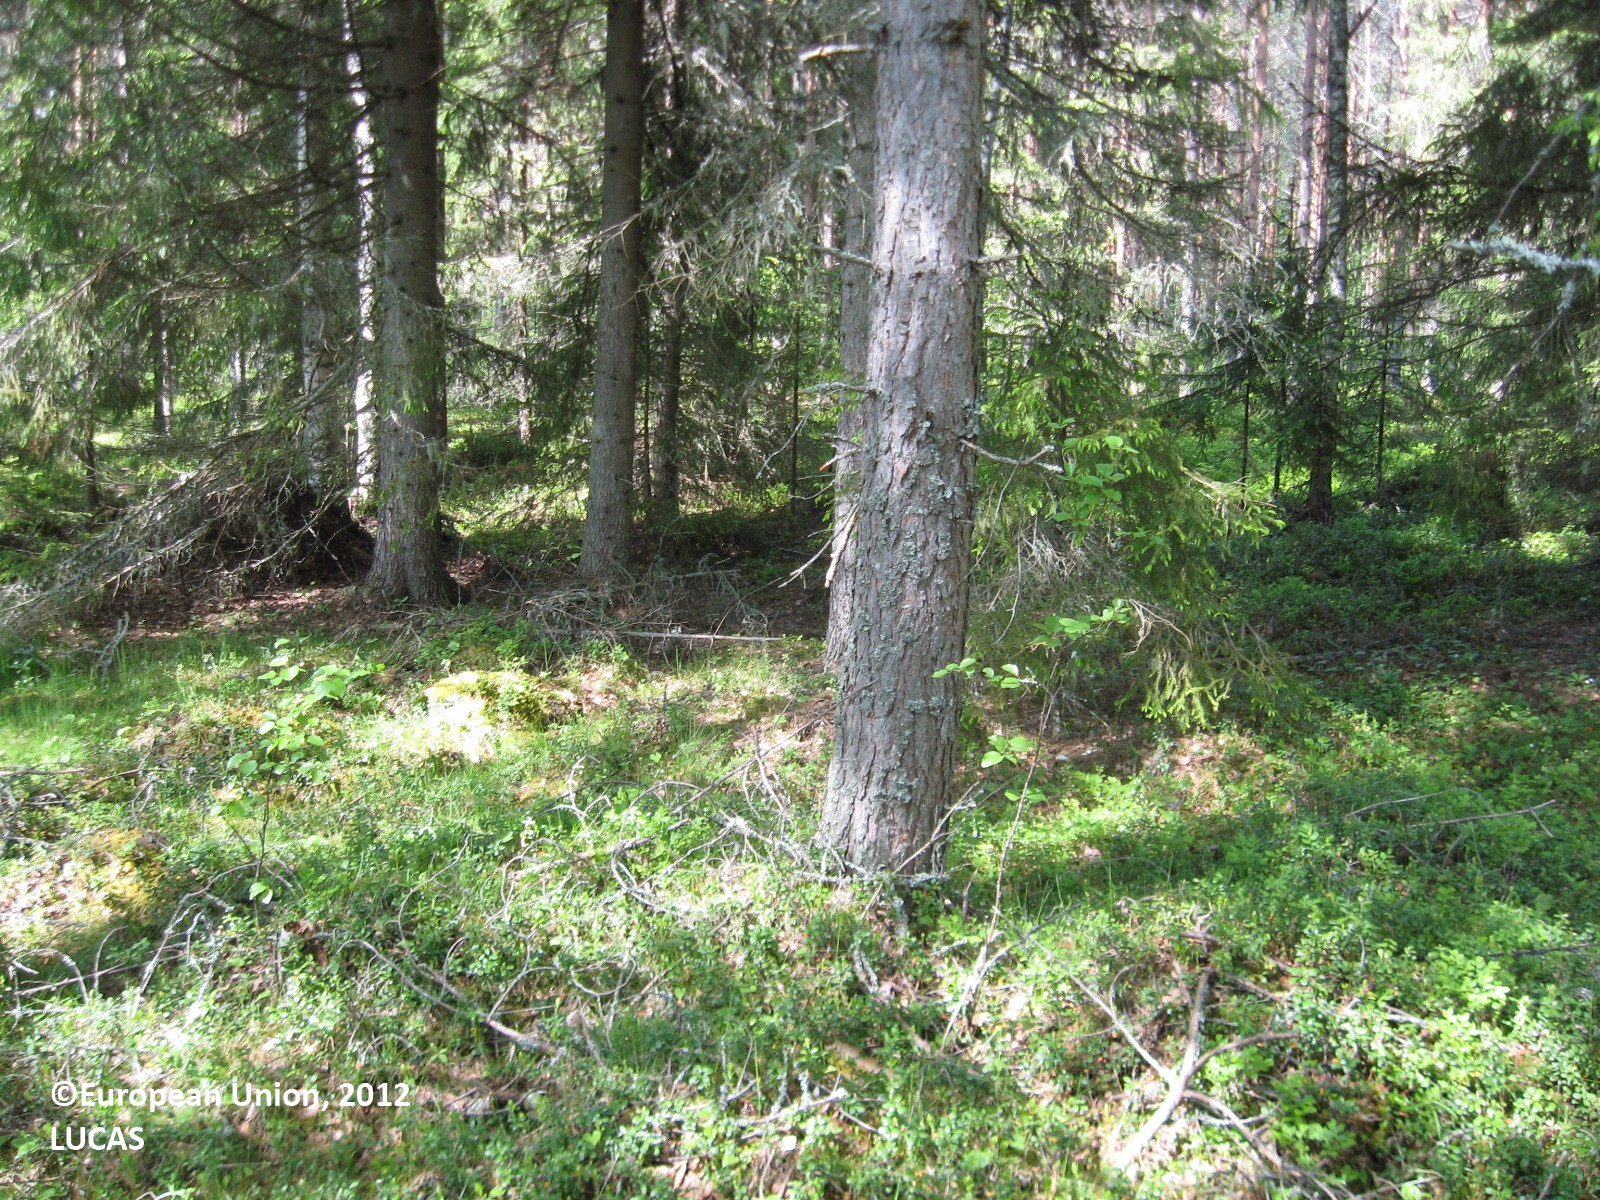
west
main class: Woodland
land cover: Broadleaved woodland
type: boreal forest
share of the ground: > 75 %
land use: Forestry
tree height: > 5 m
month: June
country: FI
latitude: 63.1503
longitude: 22.0512
